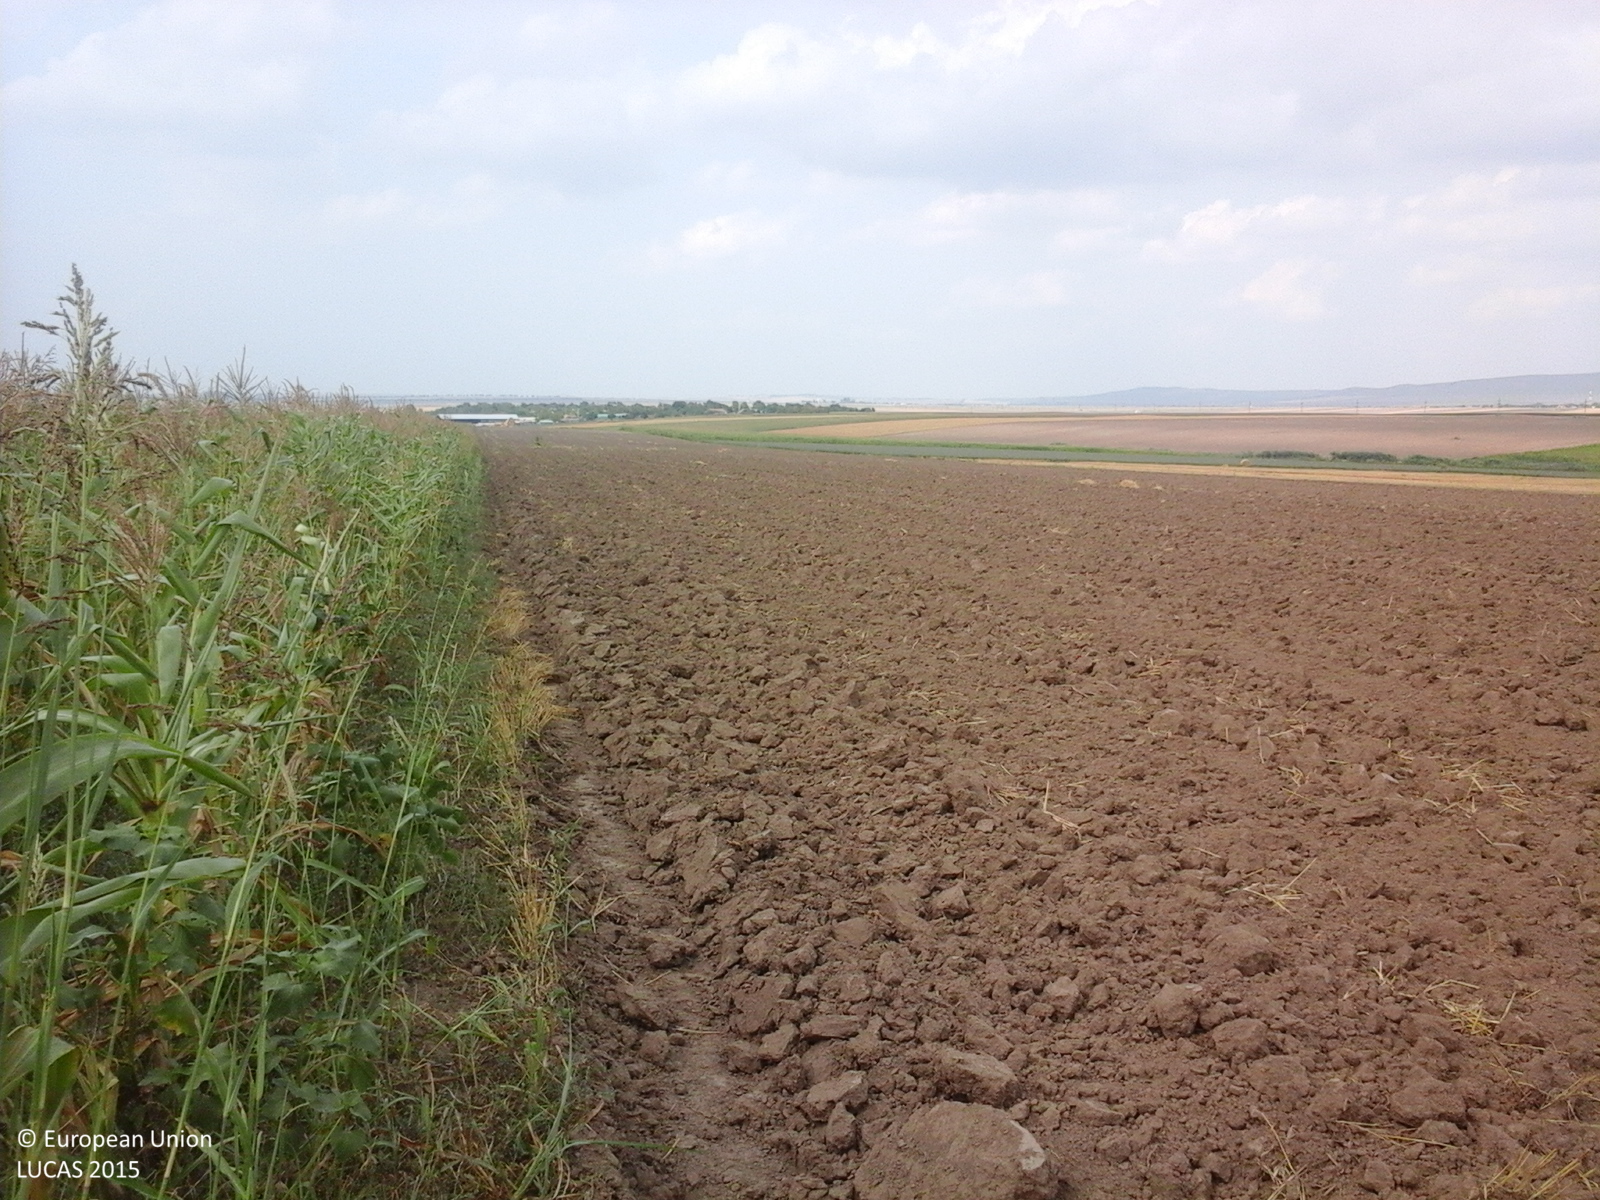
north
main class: Cropland
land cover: Maize
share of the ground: > 75 %
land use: Agriculture (excluding fallow land and kitchen gardens)
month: July
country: RO
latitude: 45.0152
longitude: 28.7001
